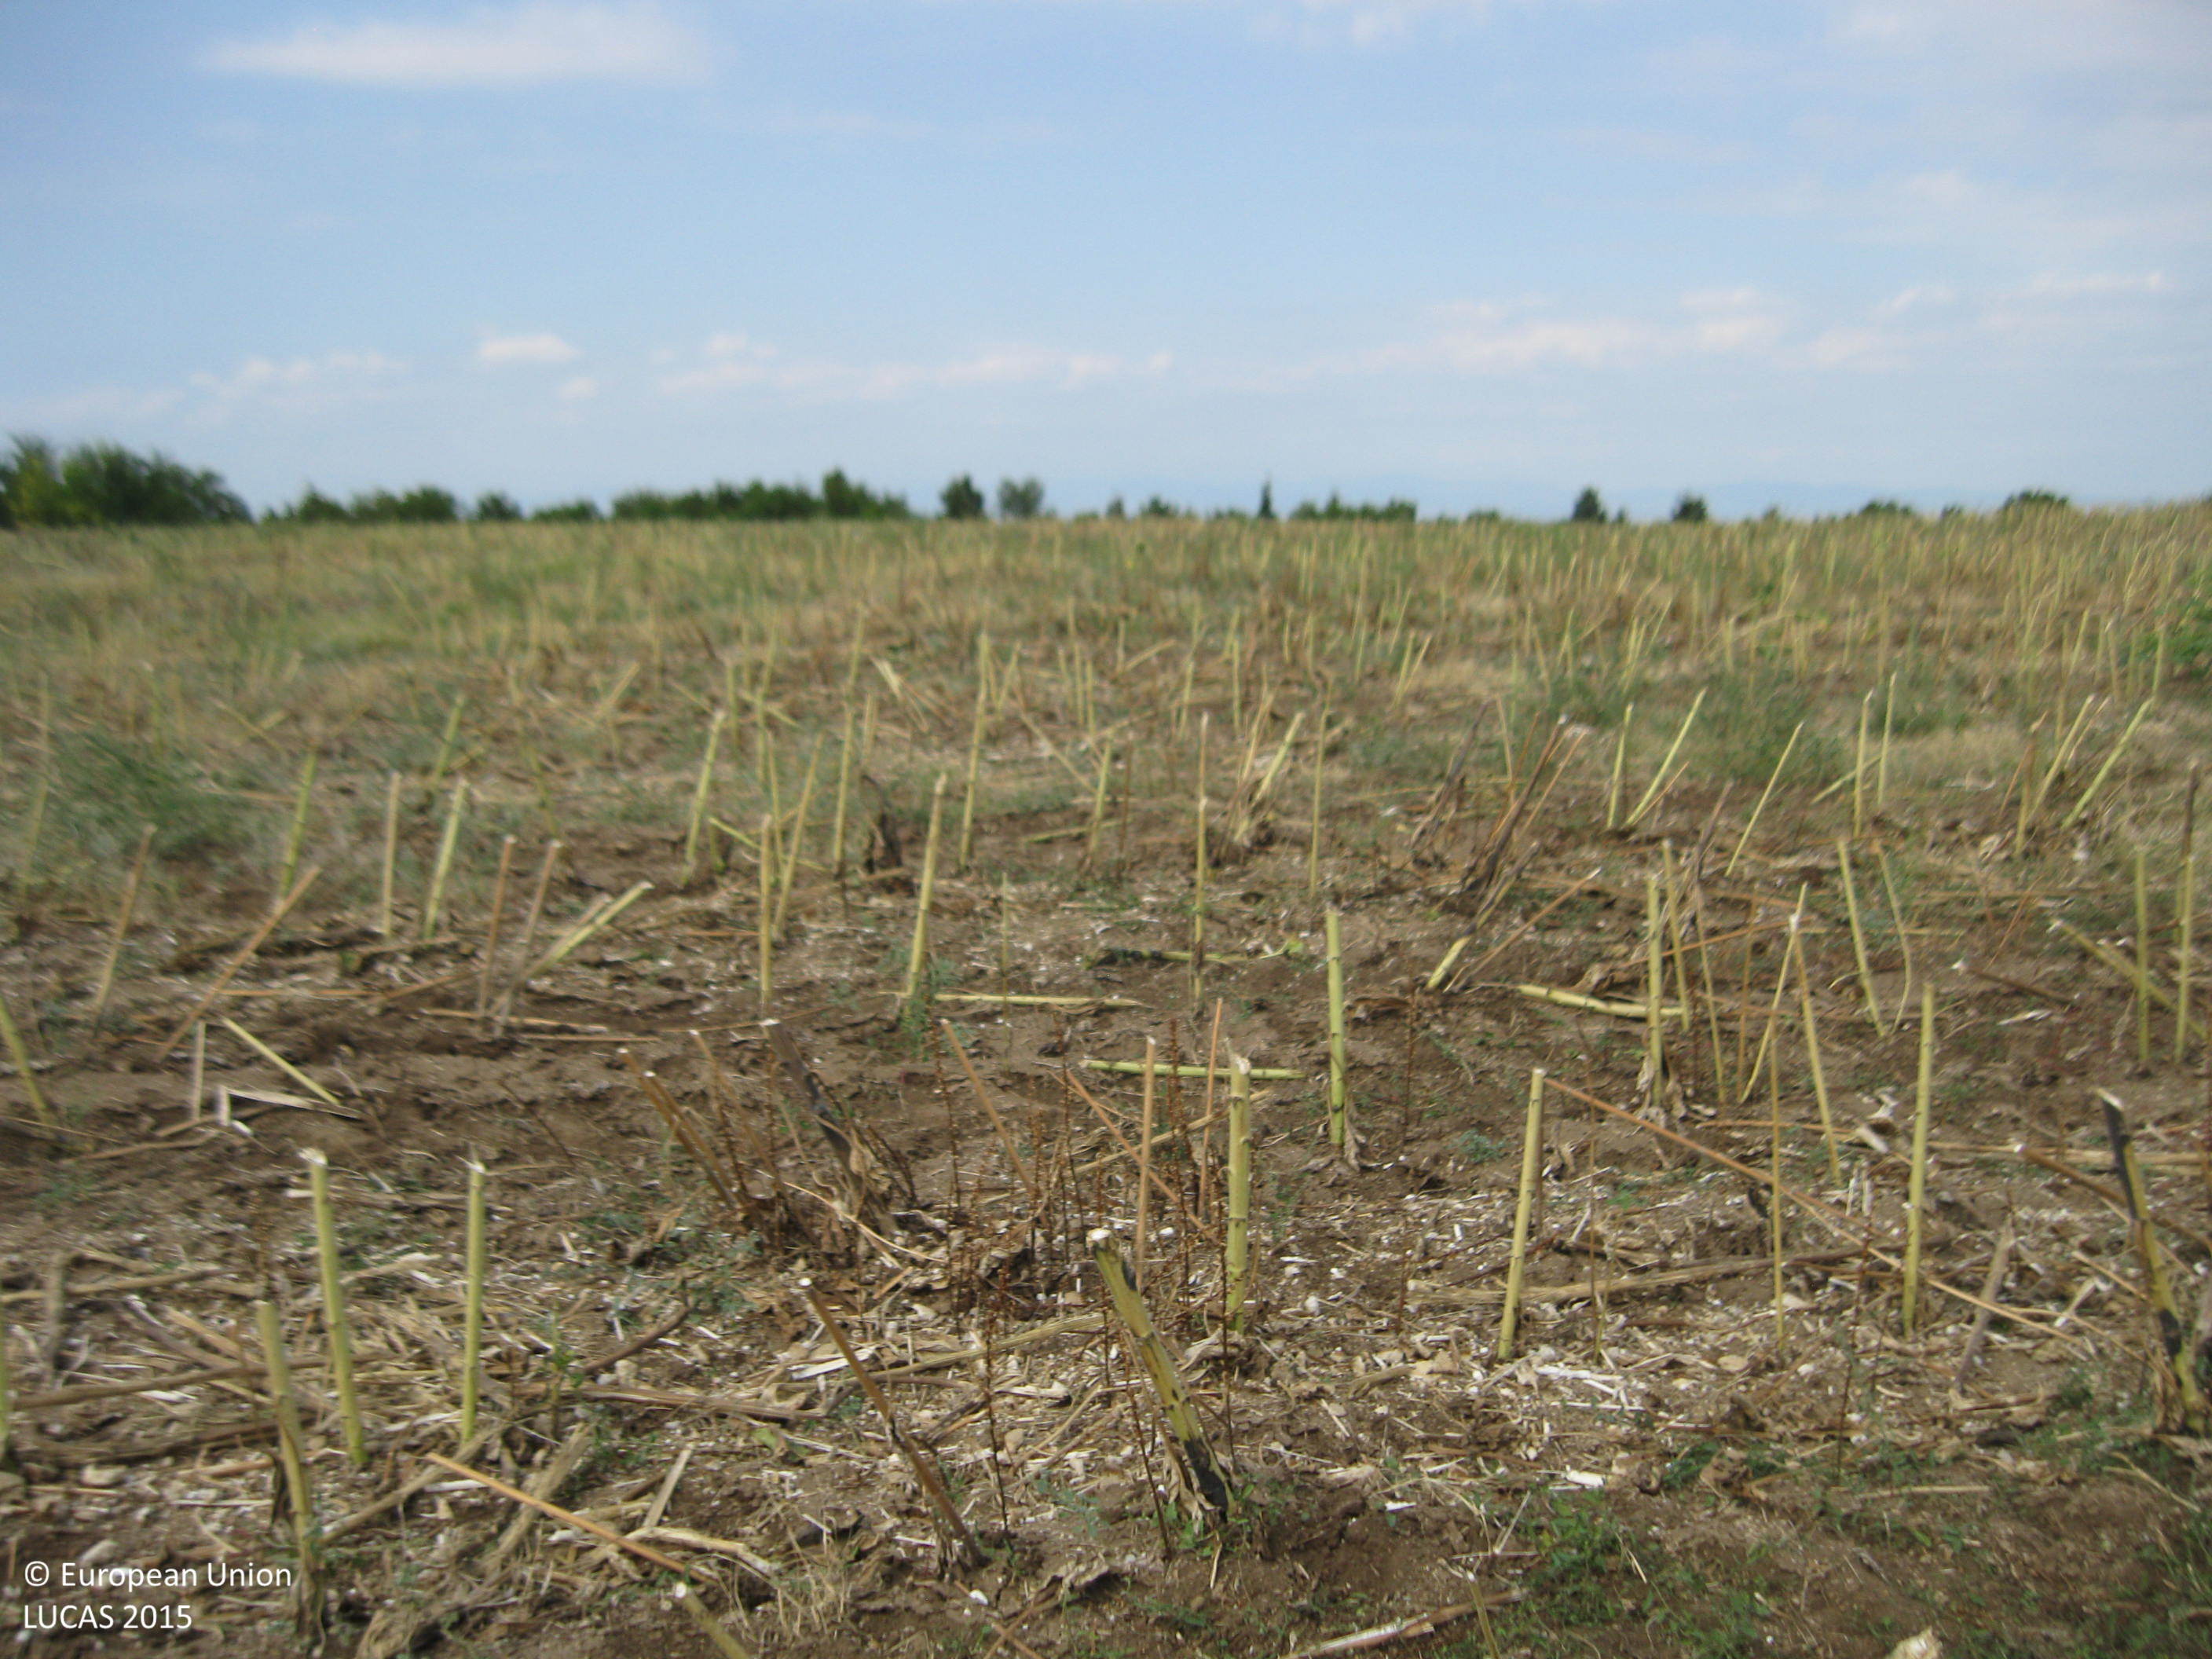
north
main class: Cropland
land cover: Sunflower
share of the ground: < 10 %
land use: Agriculture (excluding fallow land and kitchen gardens)
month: September
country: BG
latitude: 42.0996
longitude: 25.1117
